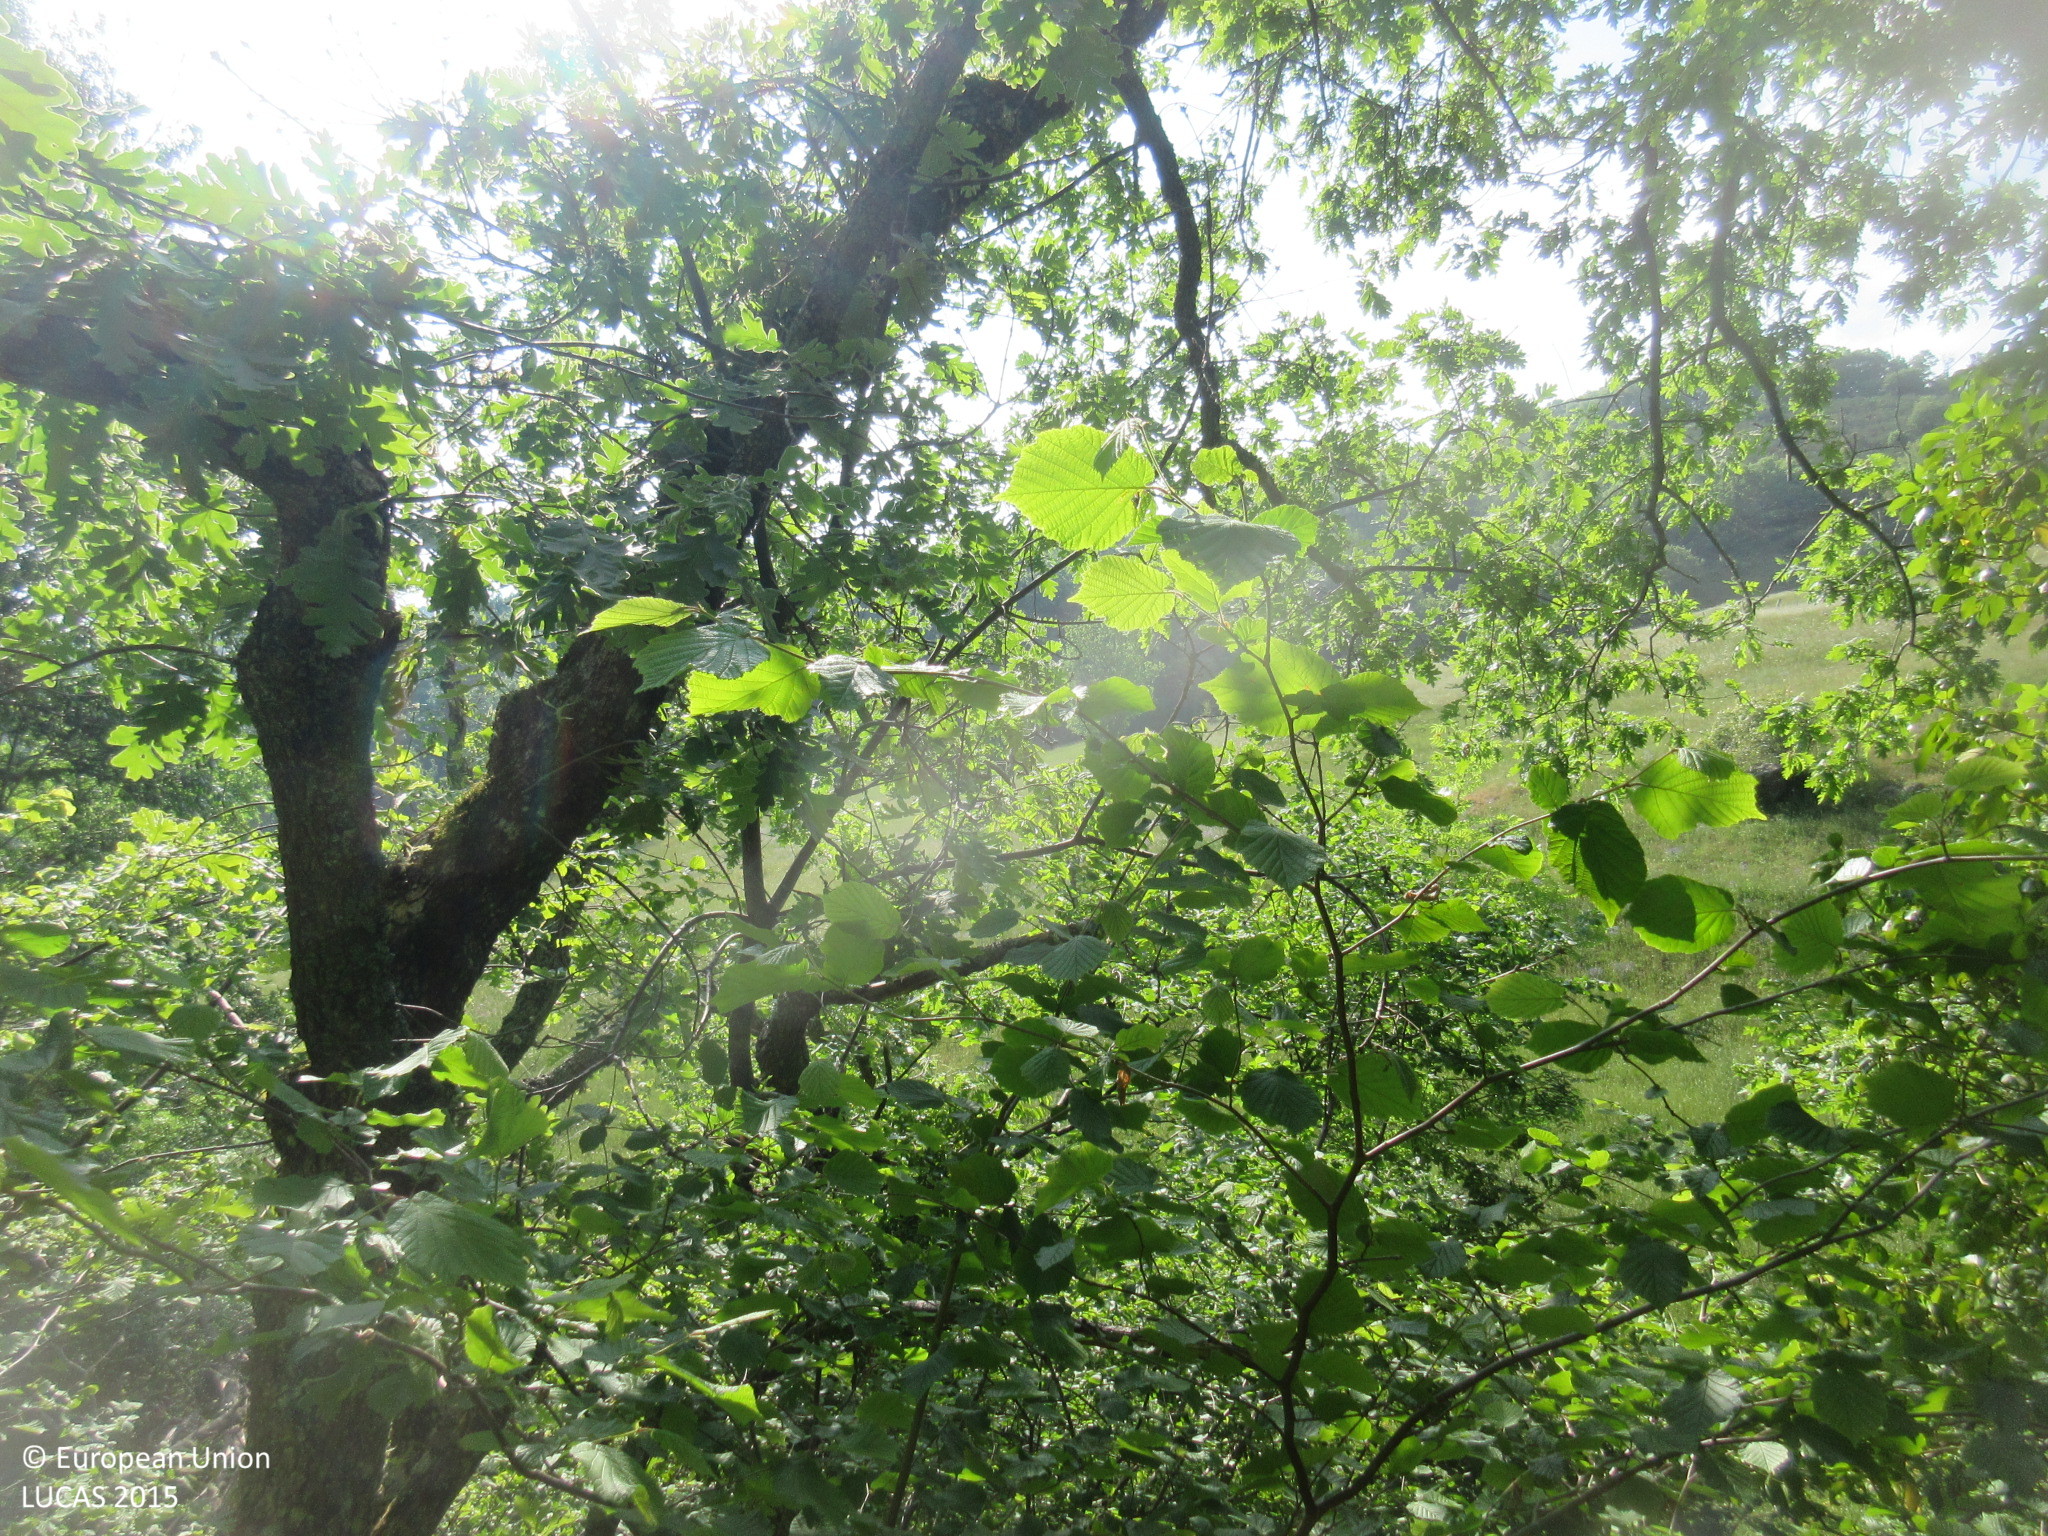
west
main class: Woodland
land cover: Broadleaved woodland
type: mesophytic deciduous forest
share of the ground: > 75 %
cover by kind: broadleaved forest trees 100 %
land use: Semi-natural and natural areas not in use
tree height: > 5 m
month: May
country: ES
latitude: 43.1881
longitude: -4.5665
